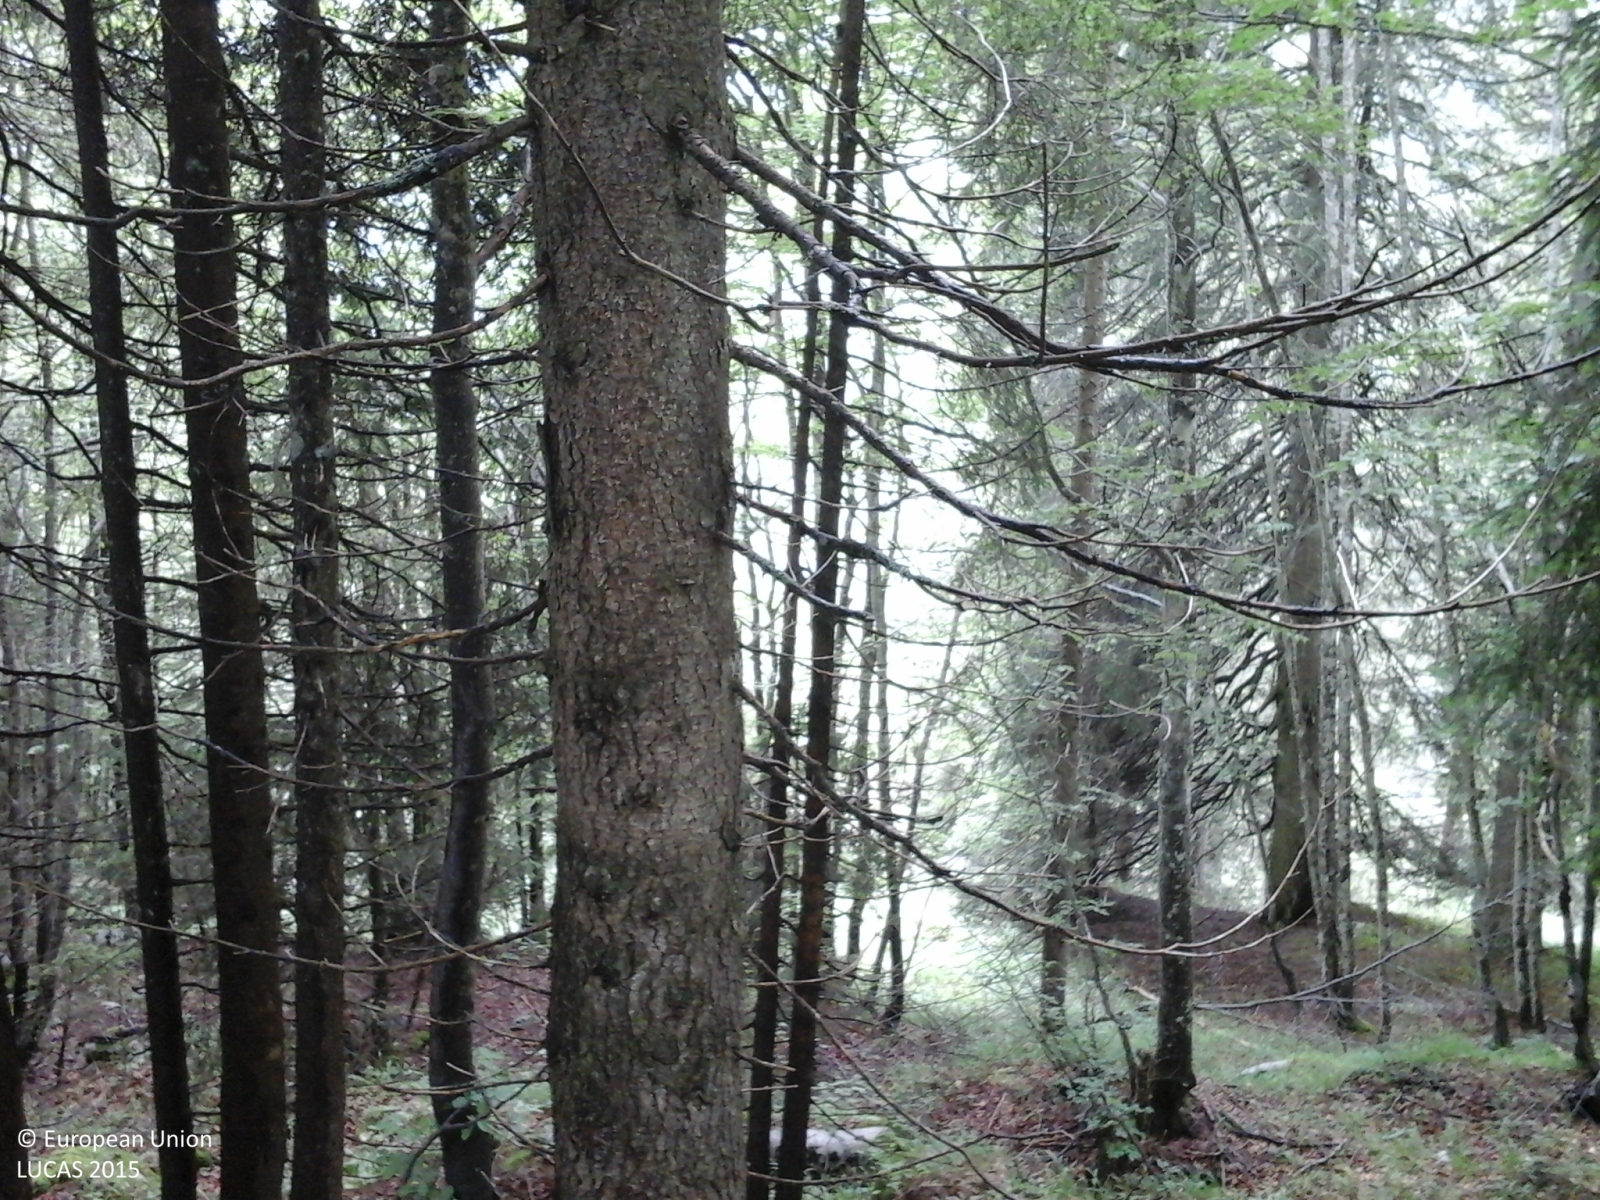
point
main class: Woodland
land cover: Spruce dominated coniferous woodland
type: alpine coniferous forest
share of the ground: > 75 %
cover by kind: coniferous forest trees 100 %
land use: Forestry
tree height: > 5 m
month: June
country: IT
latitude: 45.9438
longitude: 11.5328
